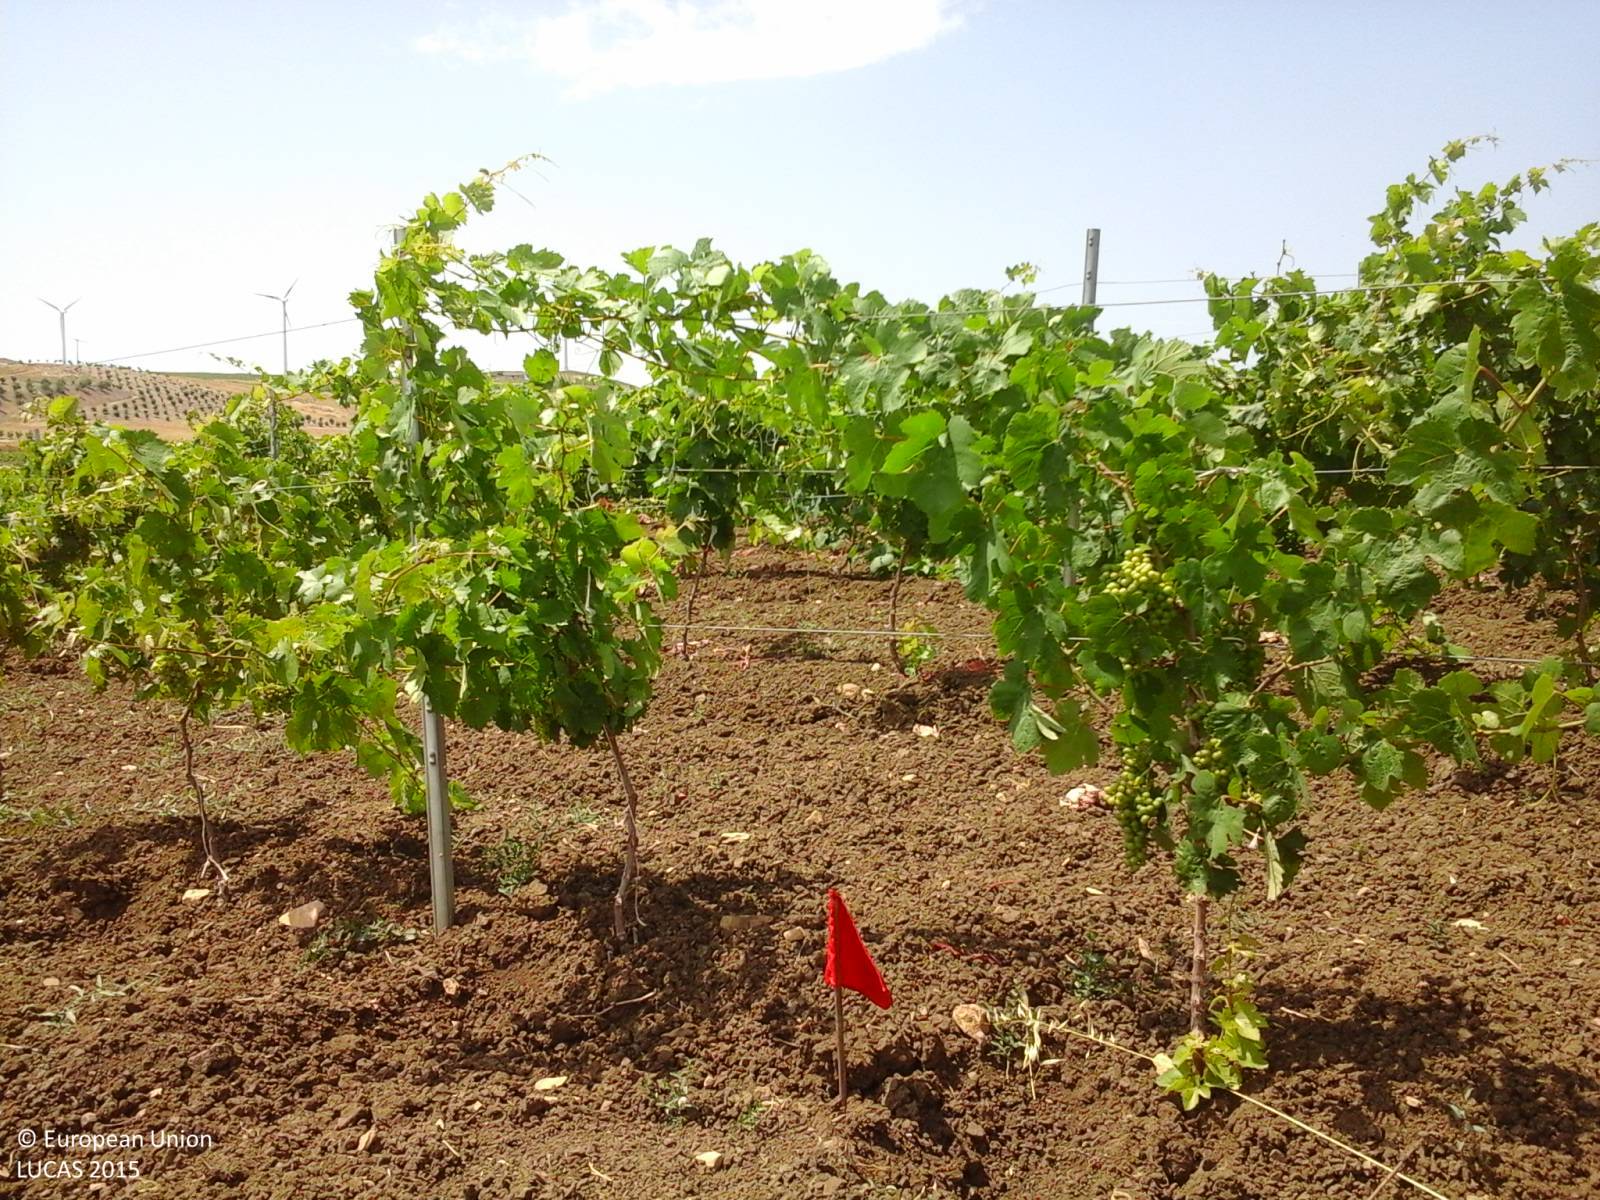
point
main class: Cropland
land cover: Vineyards
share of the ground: 50 - 75 %
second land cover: Other bare soil
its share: > 75 %
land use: Agriculture (excluding fallow land and kitchen gardens)
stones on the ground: < 10 %
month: June
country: IT
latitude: 37.8546
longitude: 12.6964
